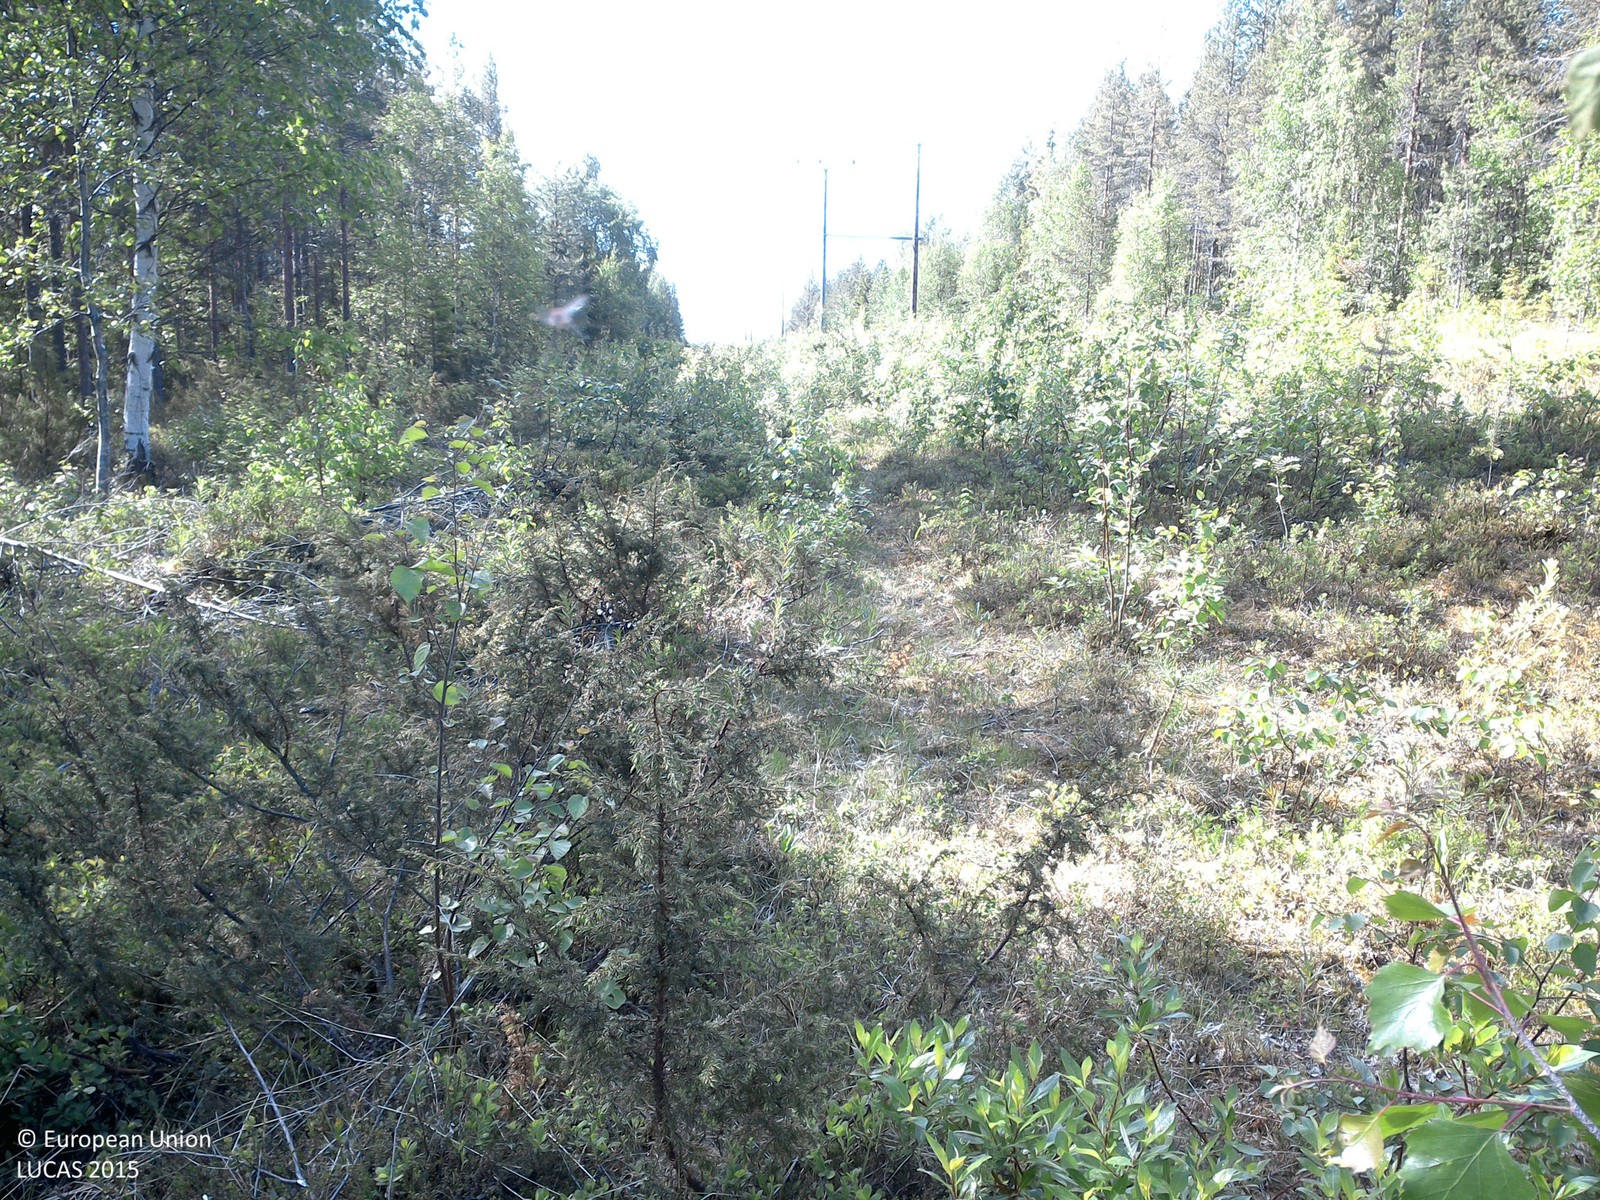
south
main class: Woodland
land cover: Broadleaved woodland
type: boreal forest
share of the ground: 10 - 25 %
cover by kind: shrubs 70 %, broadleaved forest trees 15 %, lichens and mosses 10 %, herbaceous plants 5 %
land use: Community services
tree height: < 5 m
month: June
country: SE
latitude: 66.8544
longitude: 23.0364
